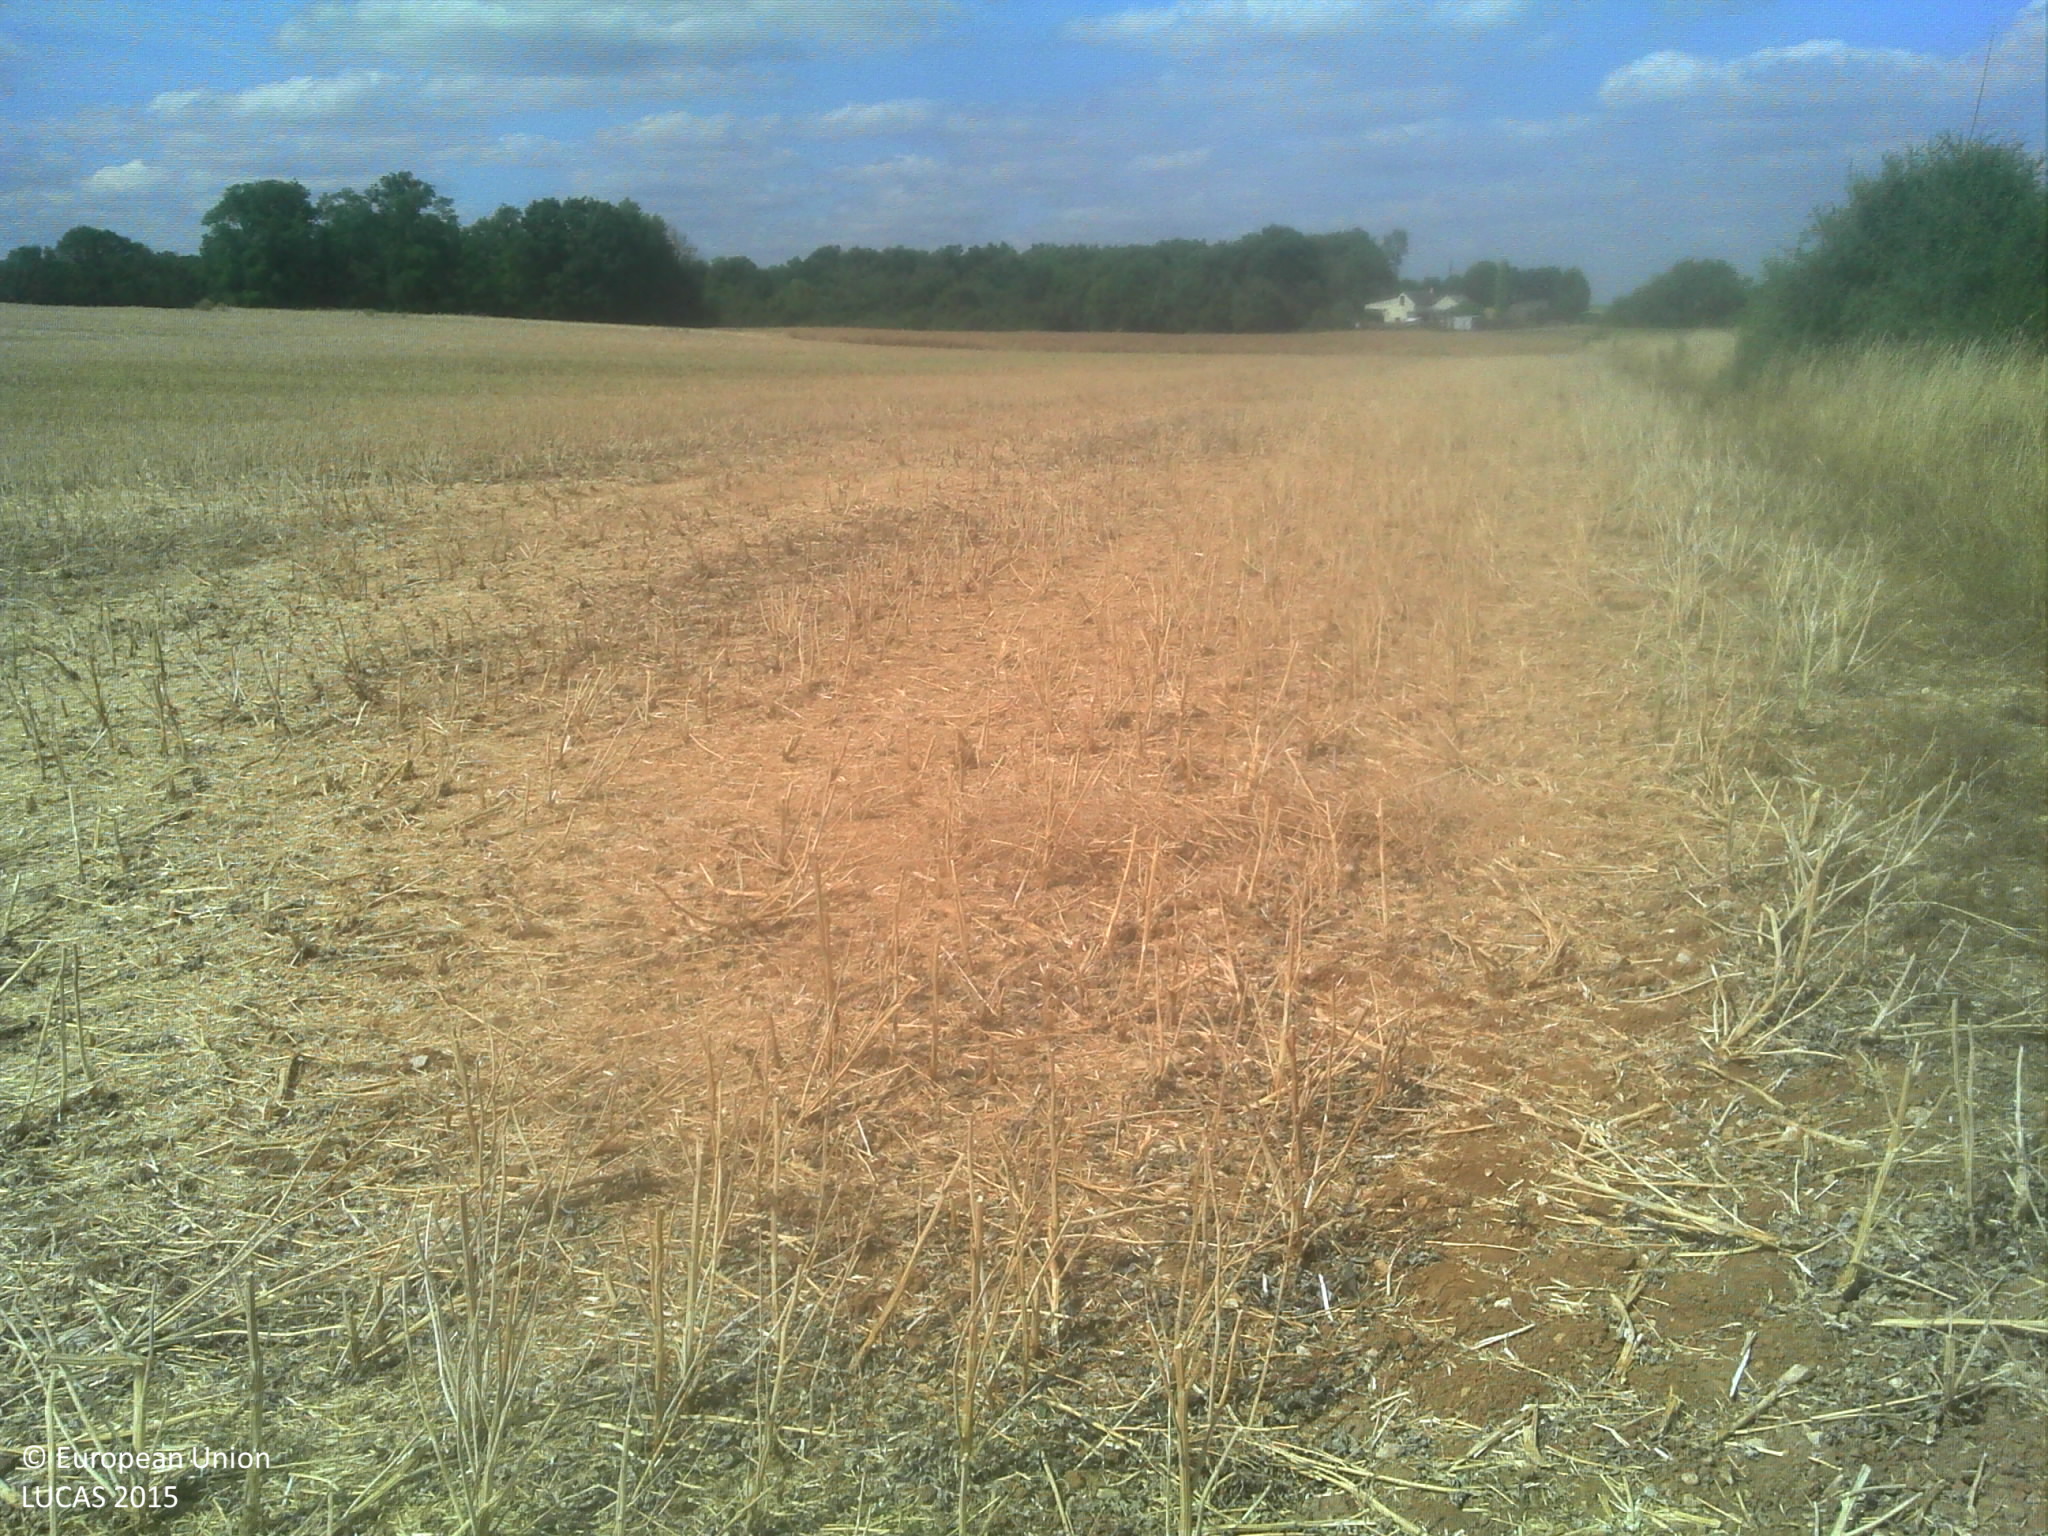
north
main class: Cropland
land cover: Rape and turnip rape
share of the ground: > 75 %
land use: Agriculture (excluding fallow land and kitchen gardens)
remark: Harvested field
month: July
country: FR
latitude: 47.9530
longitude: 1.3197
